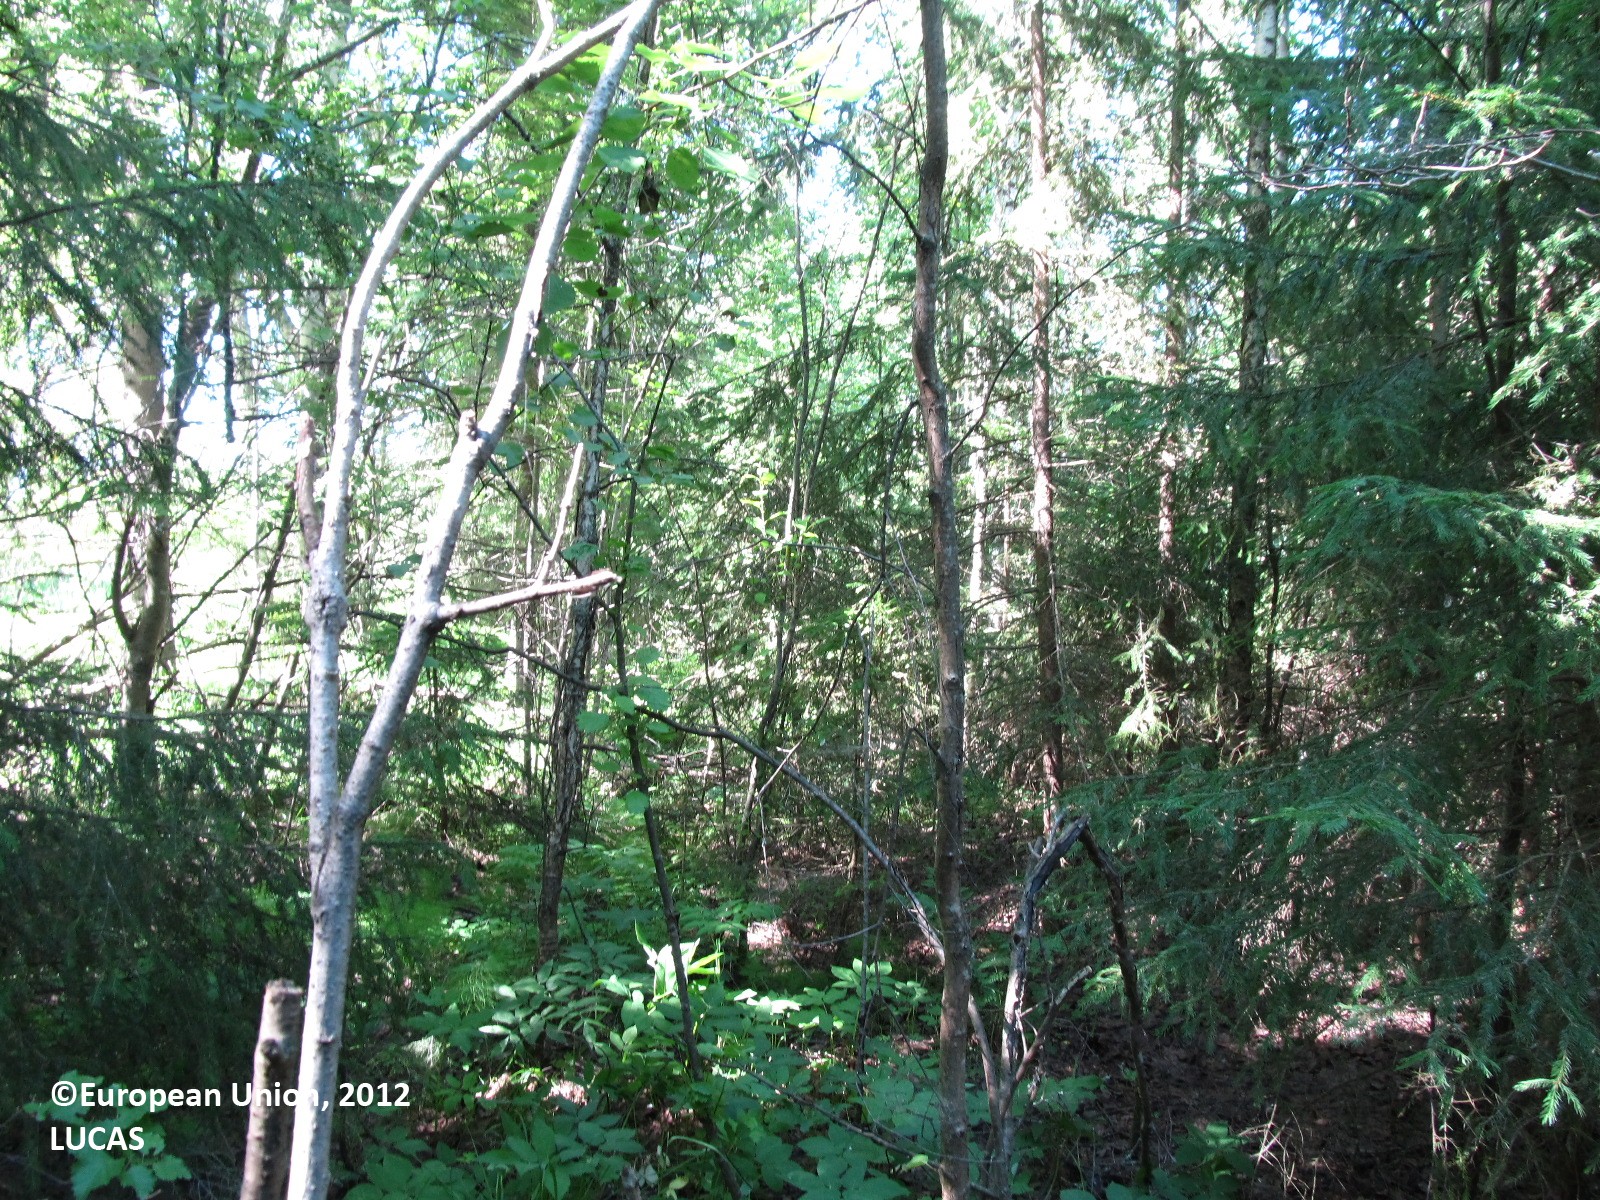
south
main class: Woodland
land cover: Spruce dominated mixed woodland
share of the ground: 50 - 75 %
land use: Forestry
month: July
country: FI
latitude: 62.2484
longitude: 29.2321
